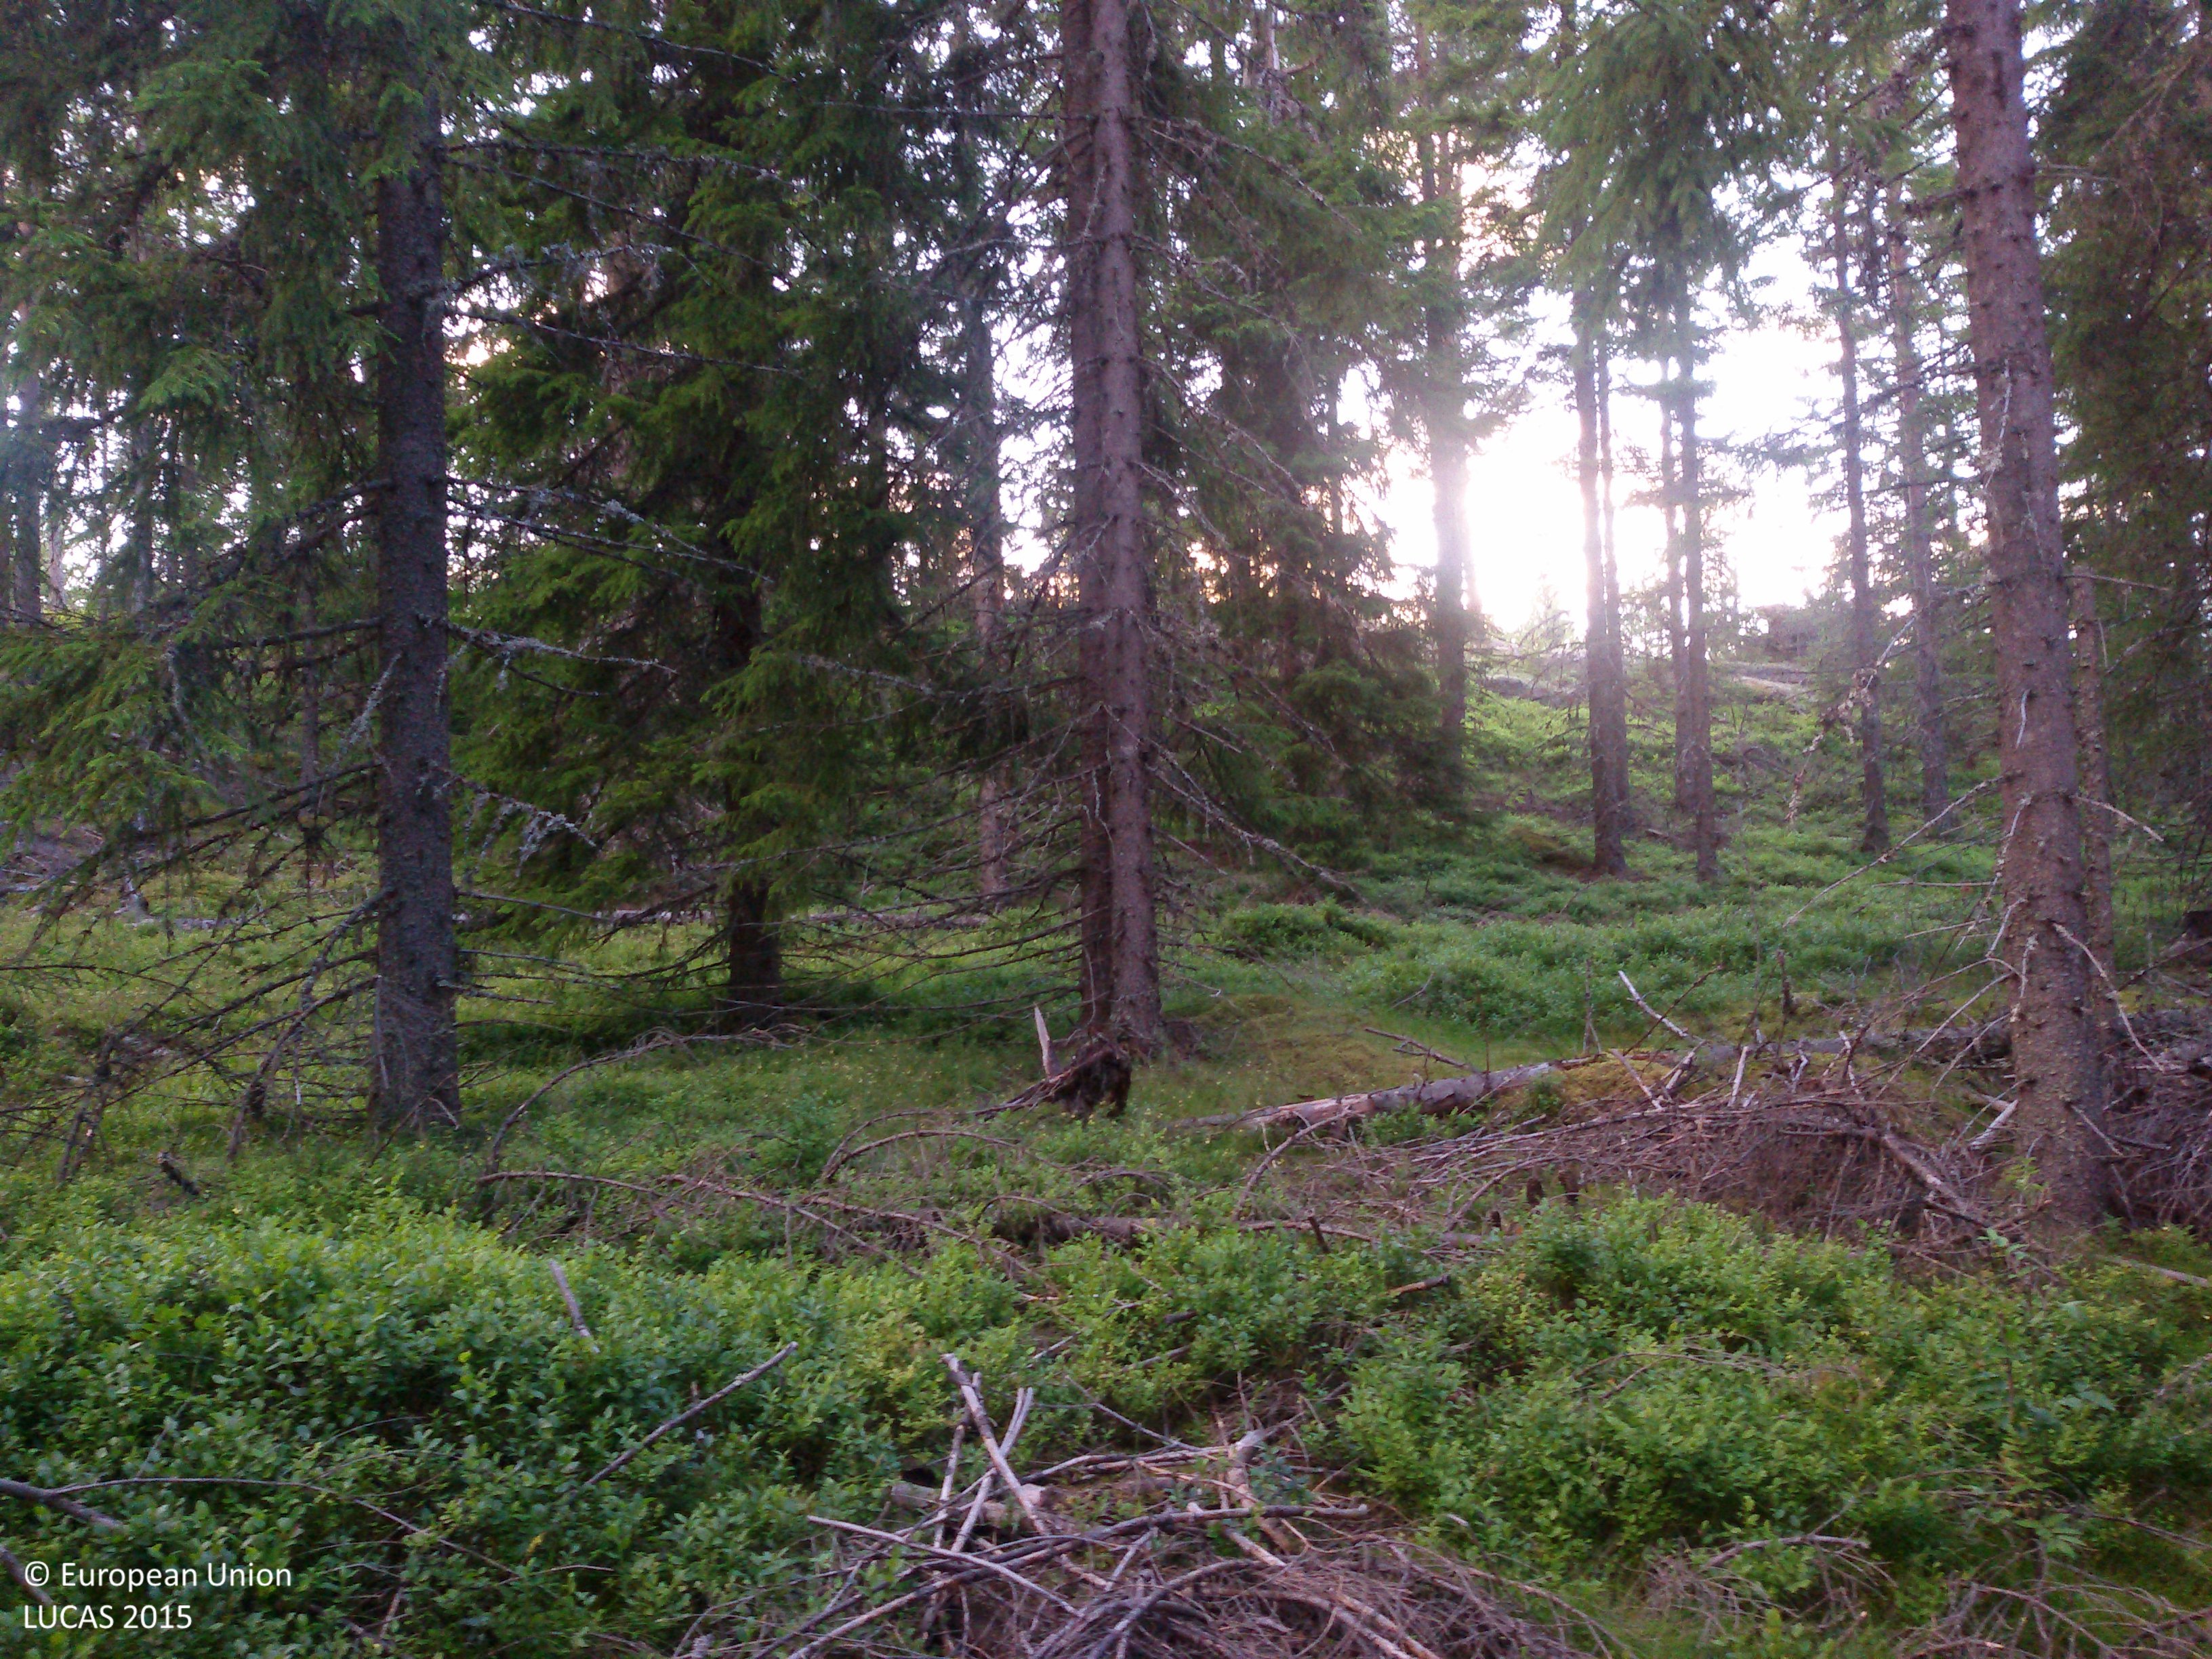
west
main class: Woodland
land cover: Spruce dominated coniferous woodland
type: boreal forest
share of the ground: 50 - 75 %
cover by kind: coniferous forest trees 70 %, herbaceous plants 30 %
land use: Forestry
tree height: > 5 m
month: July
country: SE
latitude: 60.5623
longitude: 14.9673
